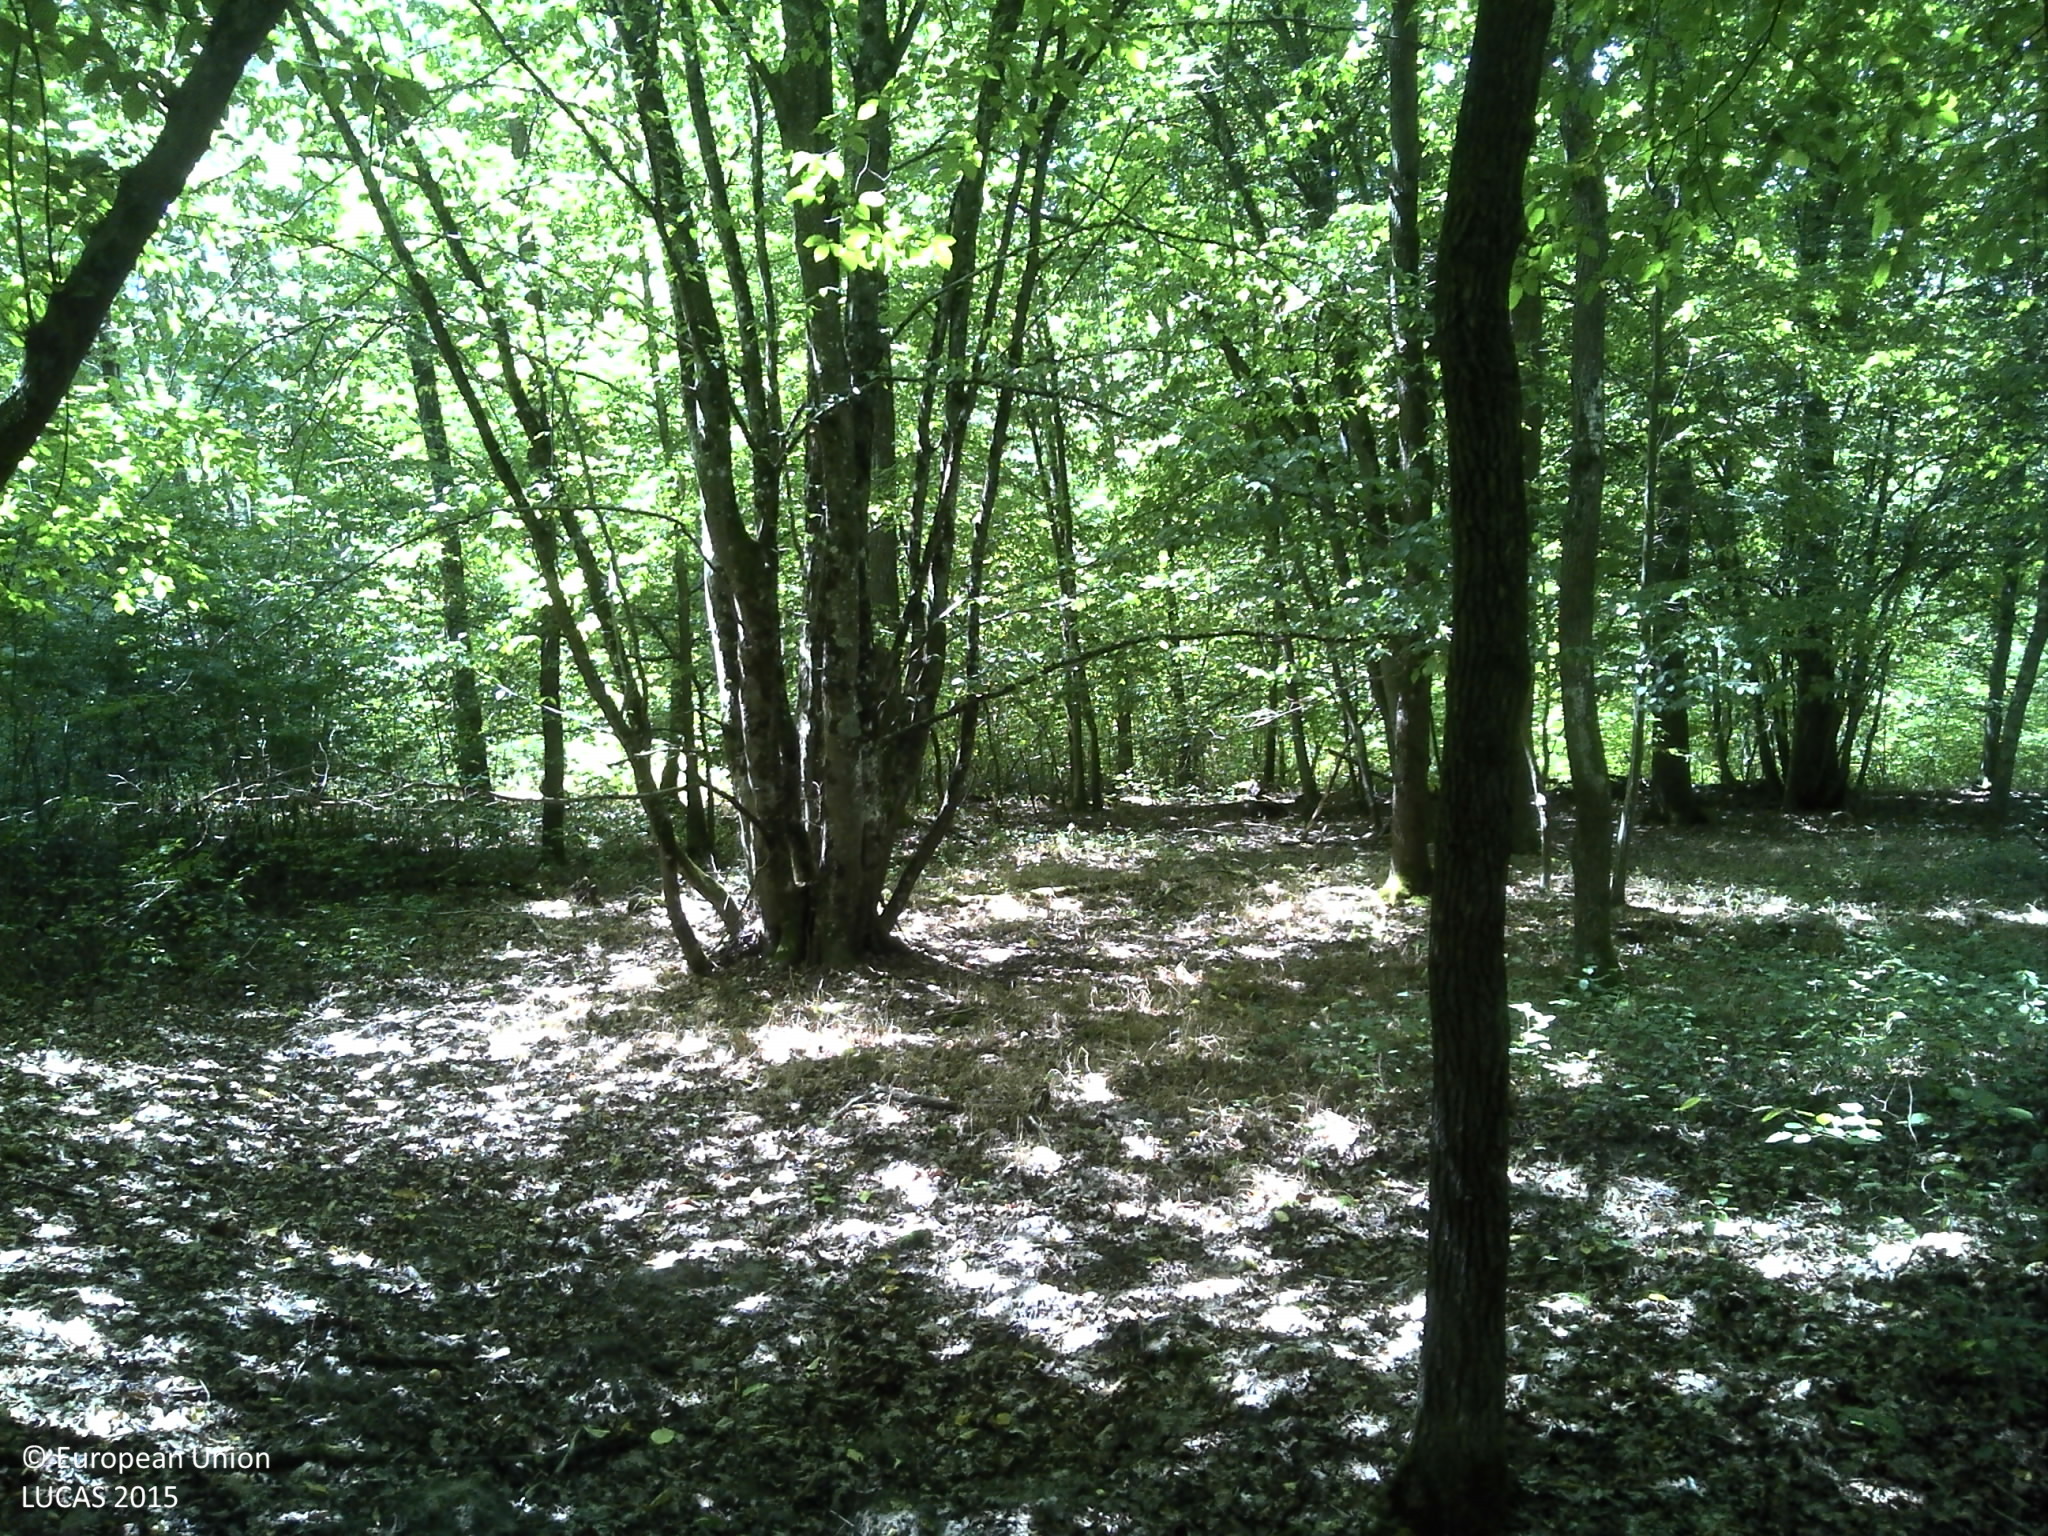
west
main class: Woodland
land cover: Broadleaved woodland
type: mesophytic deciduous forest
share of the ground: > 75 %
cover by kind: broadleaved forest trees 75 %, herbaceous plants 15 %, shrubs 10 %
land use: Forestry
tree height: > 5 m
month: July
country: FR
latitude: 45.7923
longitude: 4.1234
